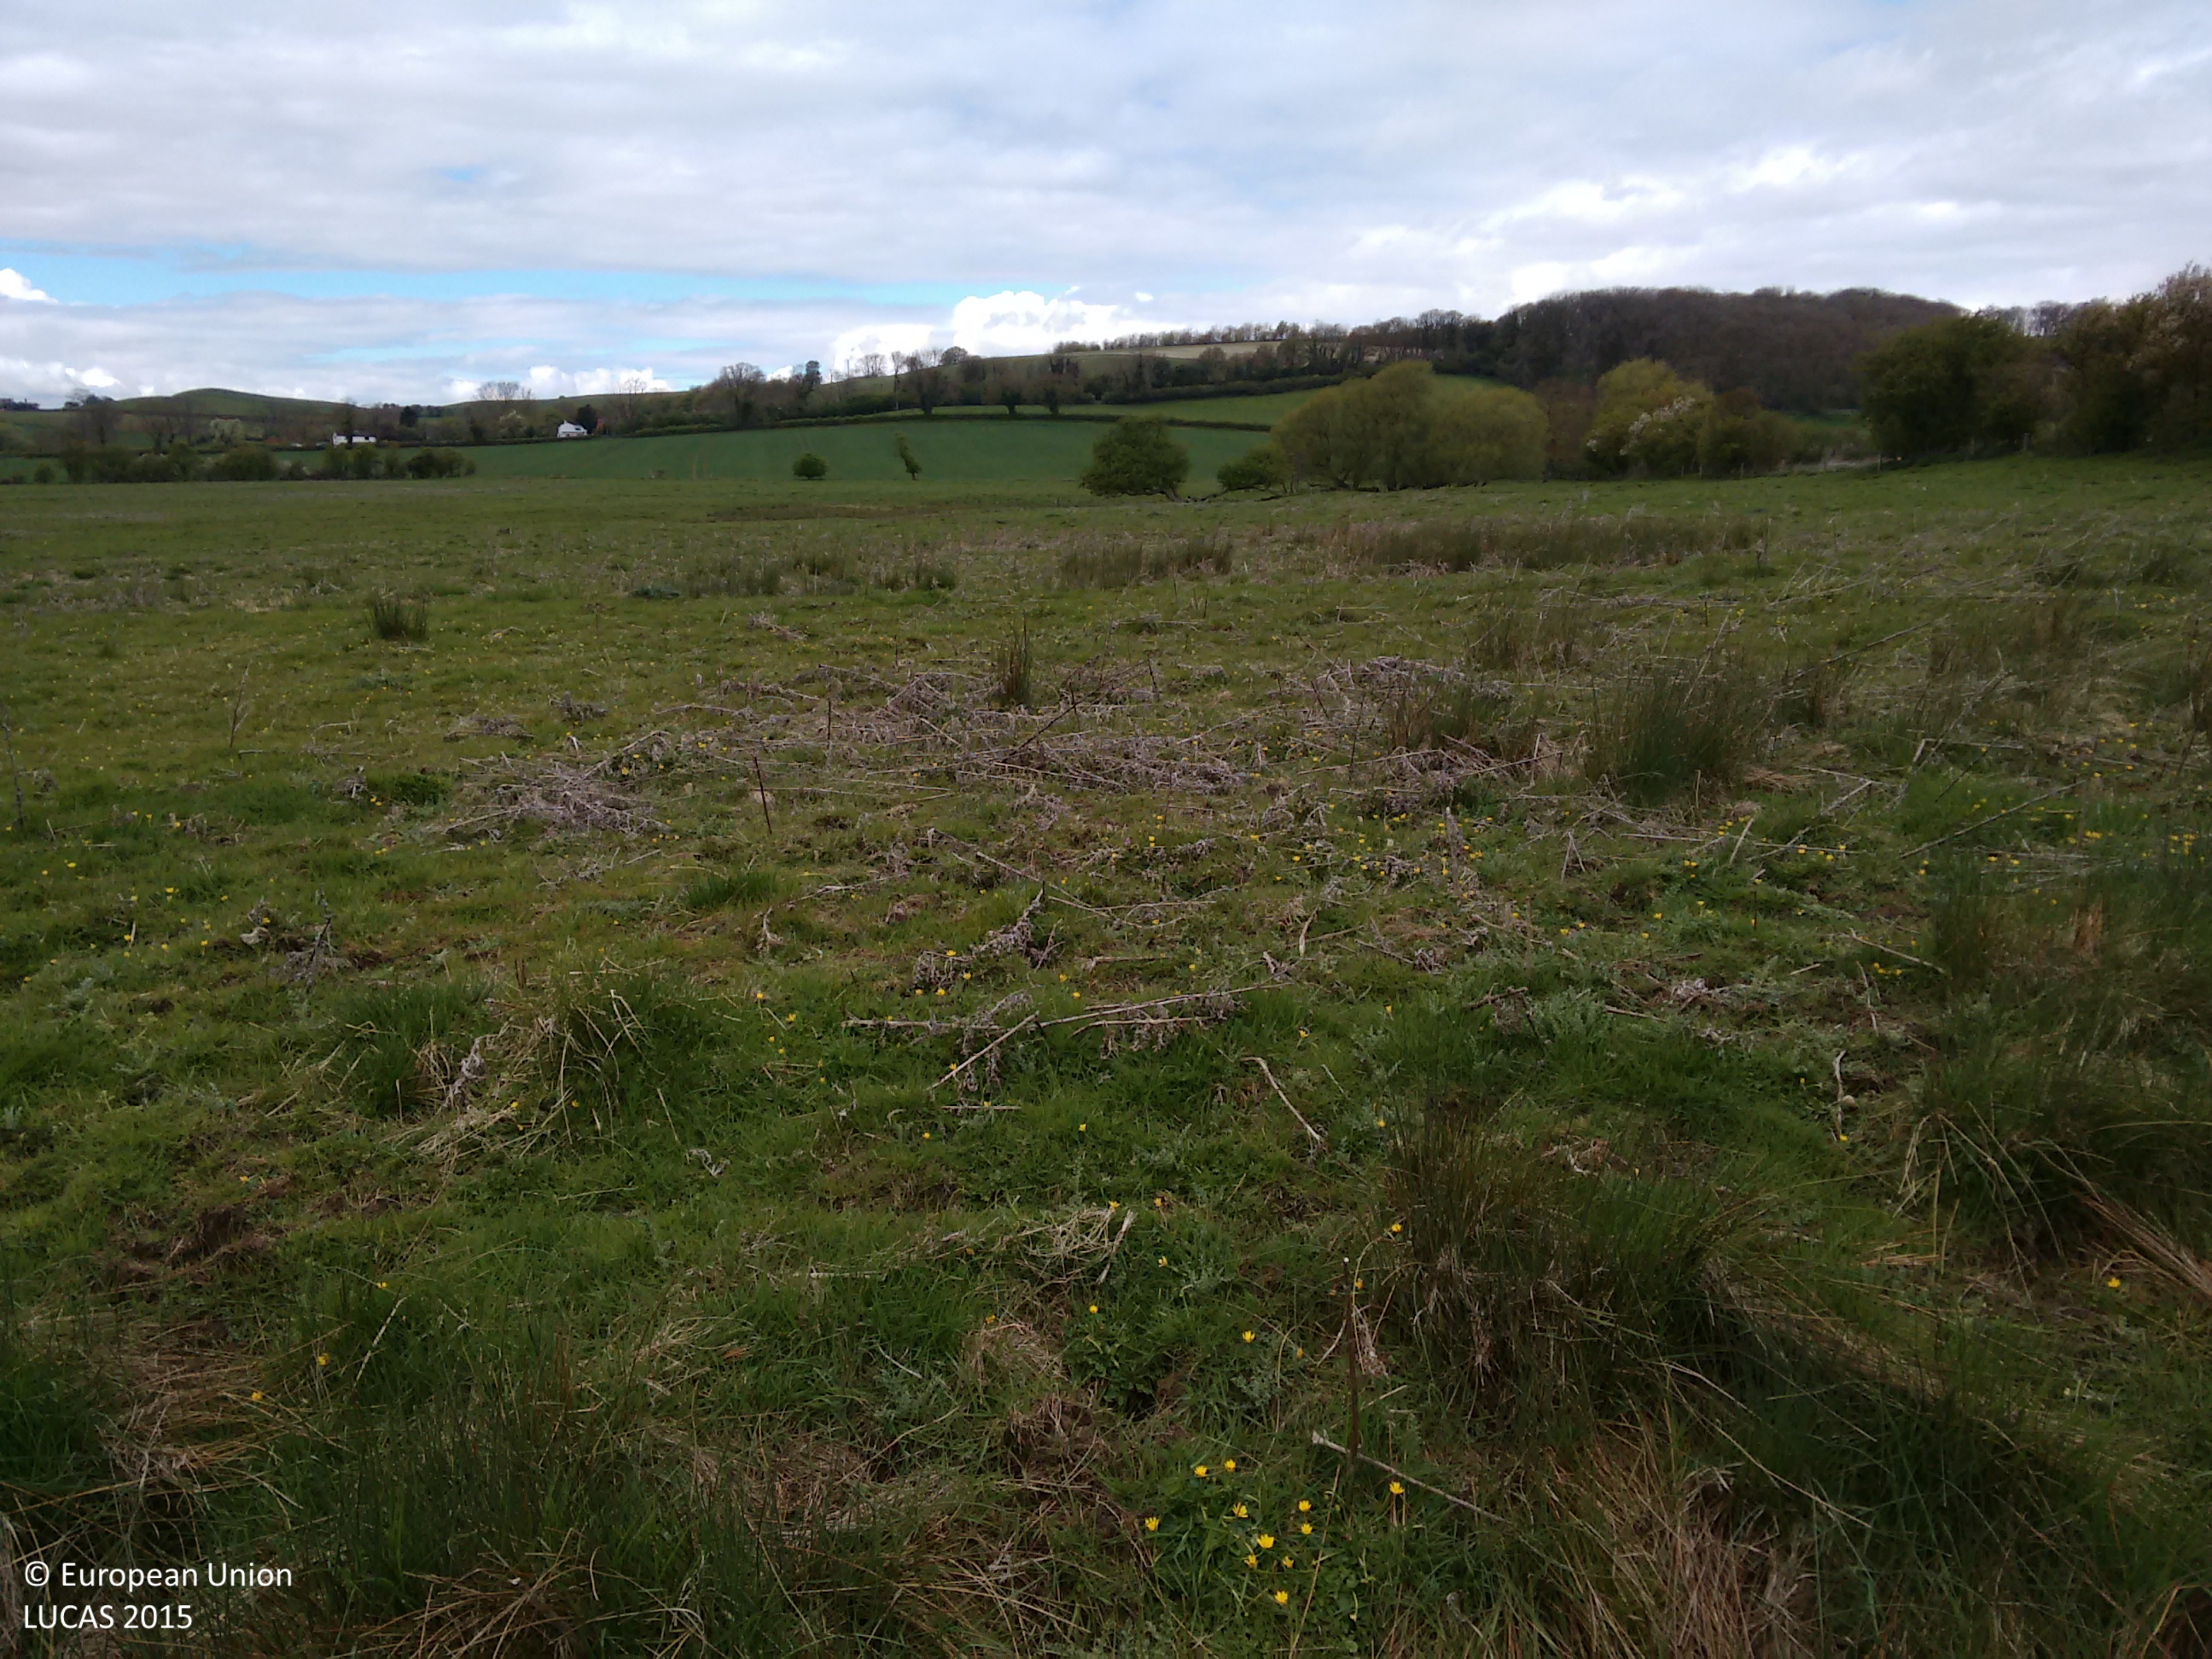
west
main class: Grassland
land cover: Grassland without tree/shrub cover
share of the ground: > 75 %
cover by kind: herbaceous plants 100 %
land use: Agriculture (excluding fallow land and kitchen gardens)
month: April
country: GB
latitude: 53.2588
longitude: -0.0006
